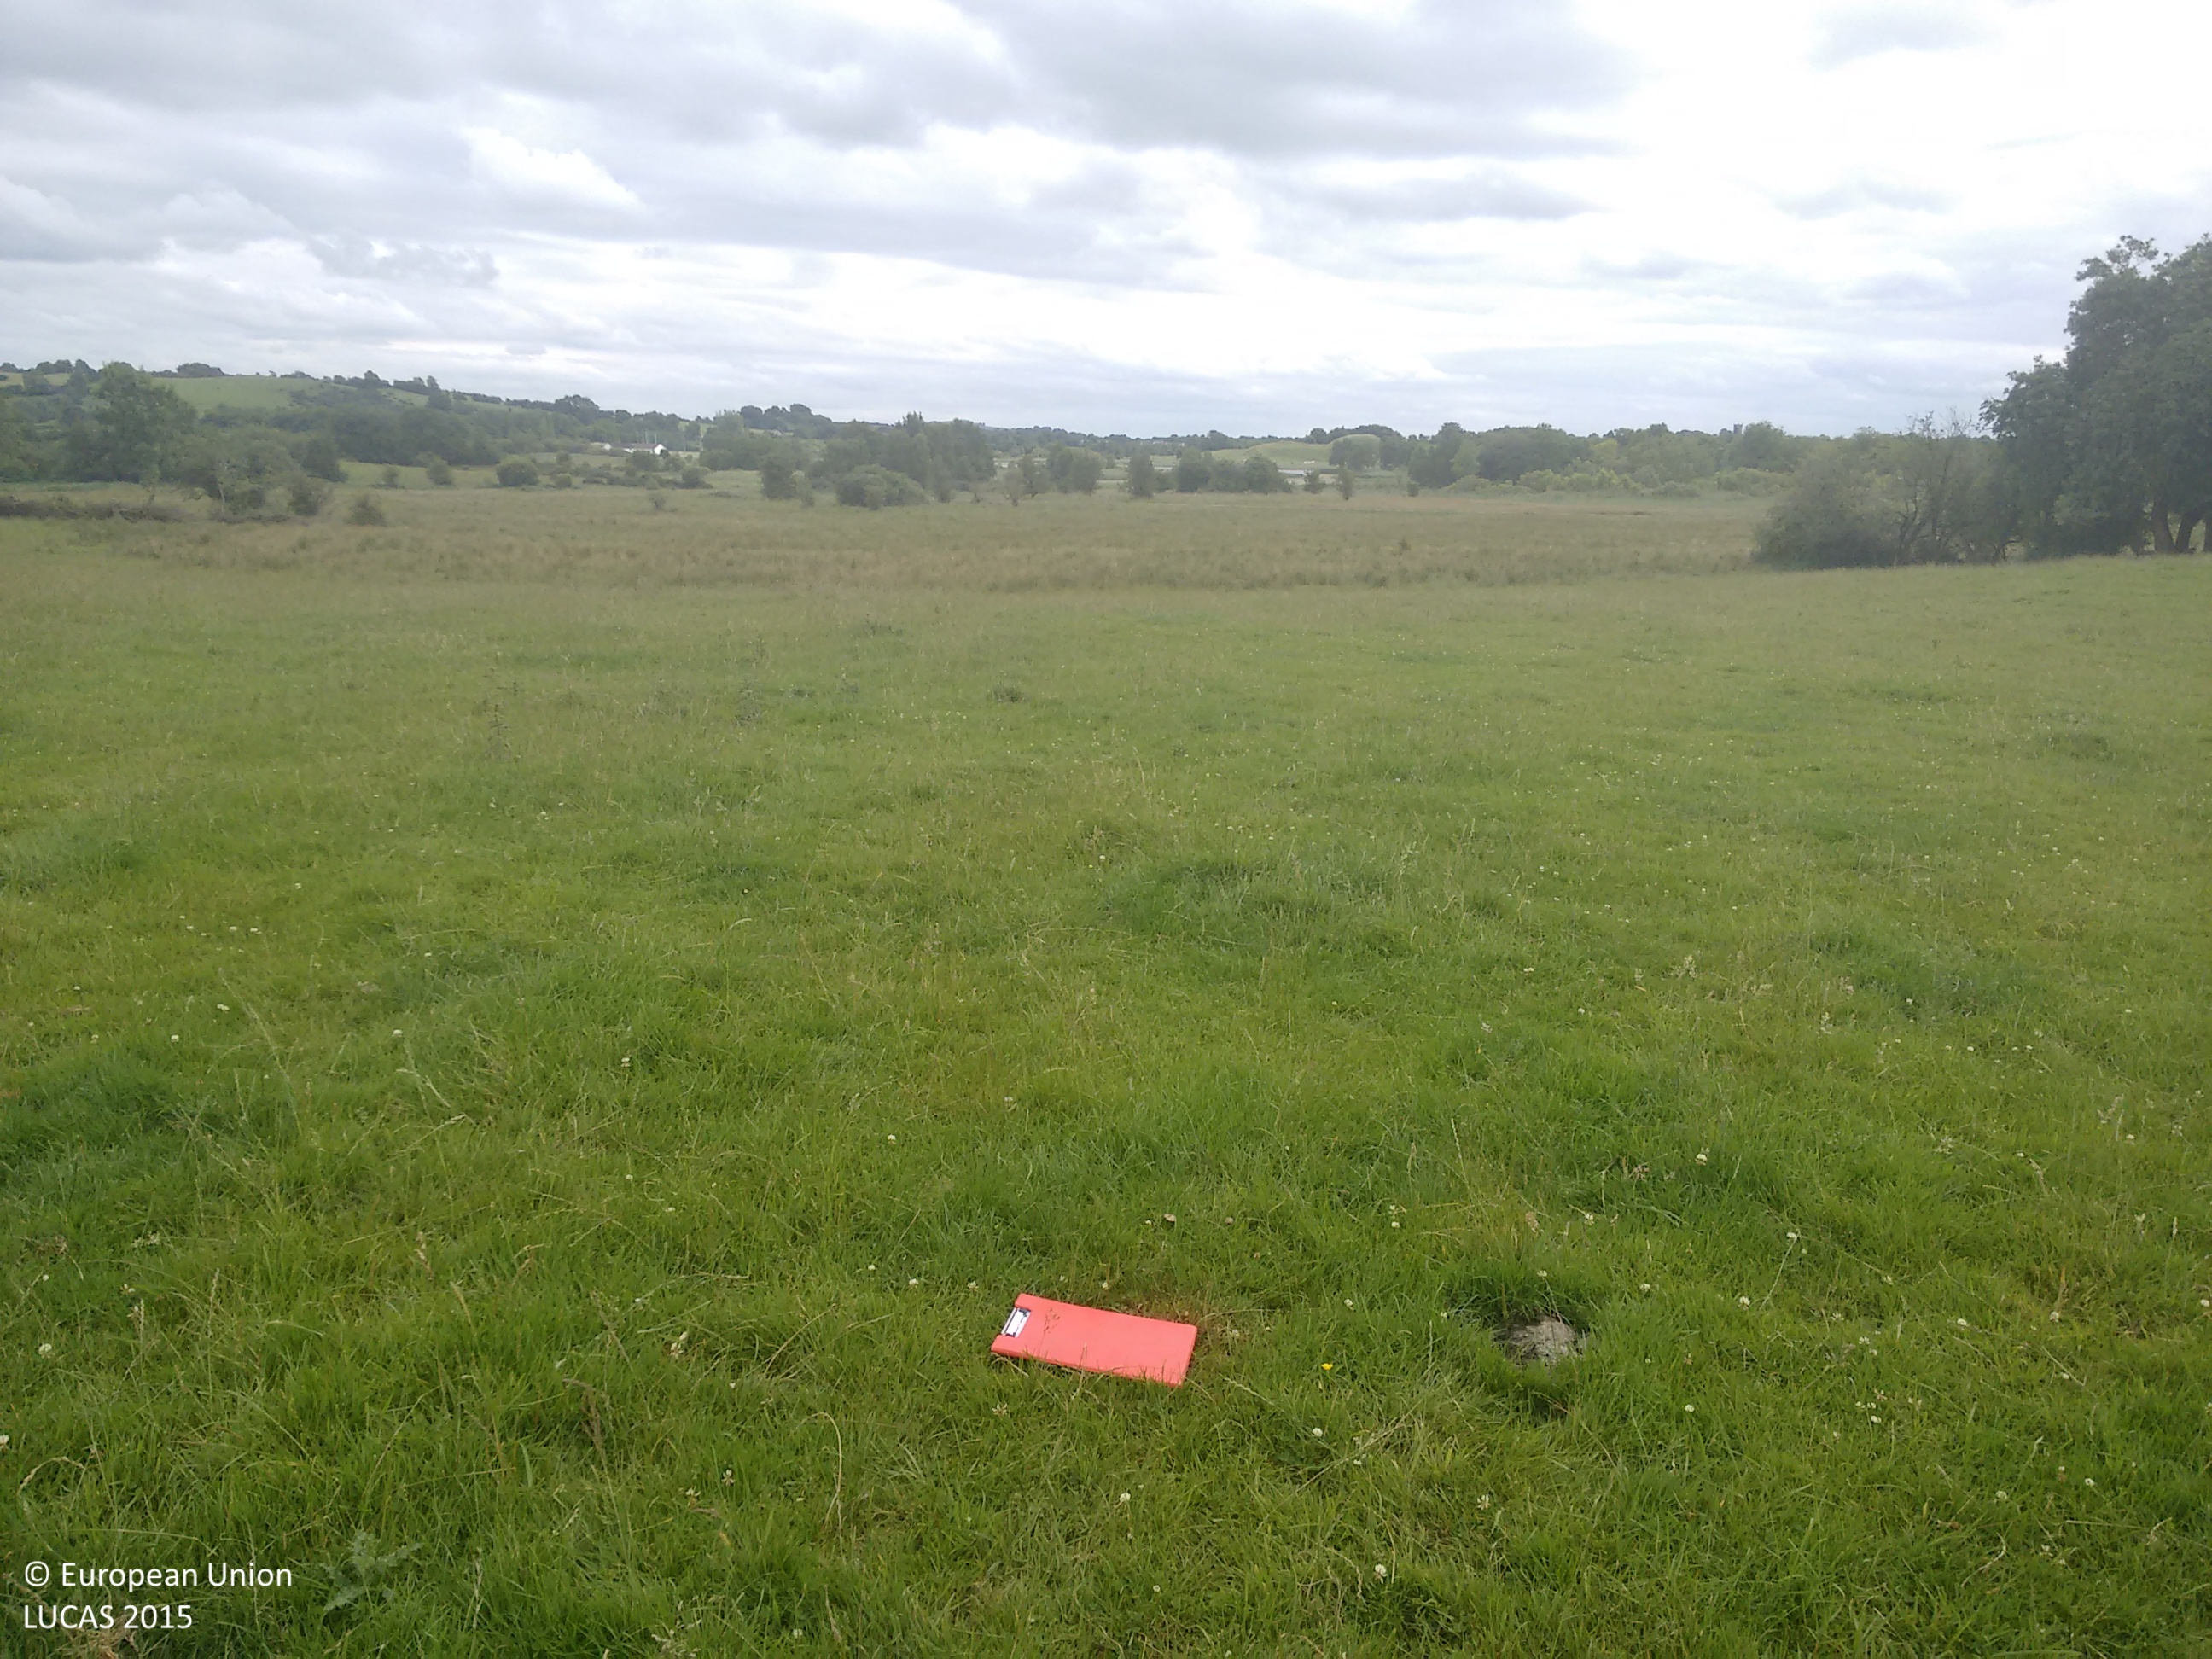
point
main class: Grassland
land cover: Grassland without tree/shrub cover
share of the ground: > 75 %
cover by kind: herbaceous plants 100 %
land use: Agriculture (excluding fallow land and kitchen gardens)
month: July
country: IE
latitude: 53.5069
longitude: -7.6691
